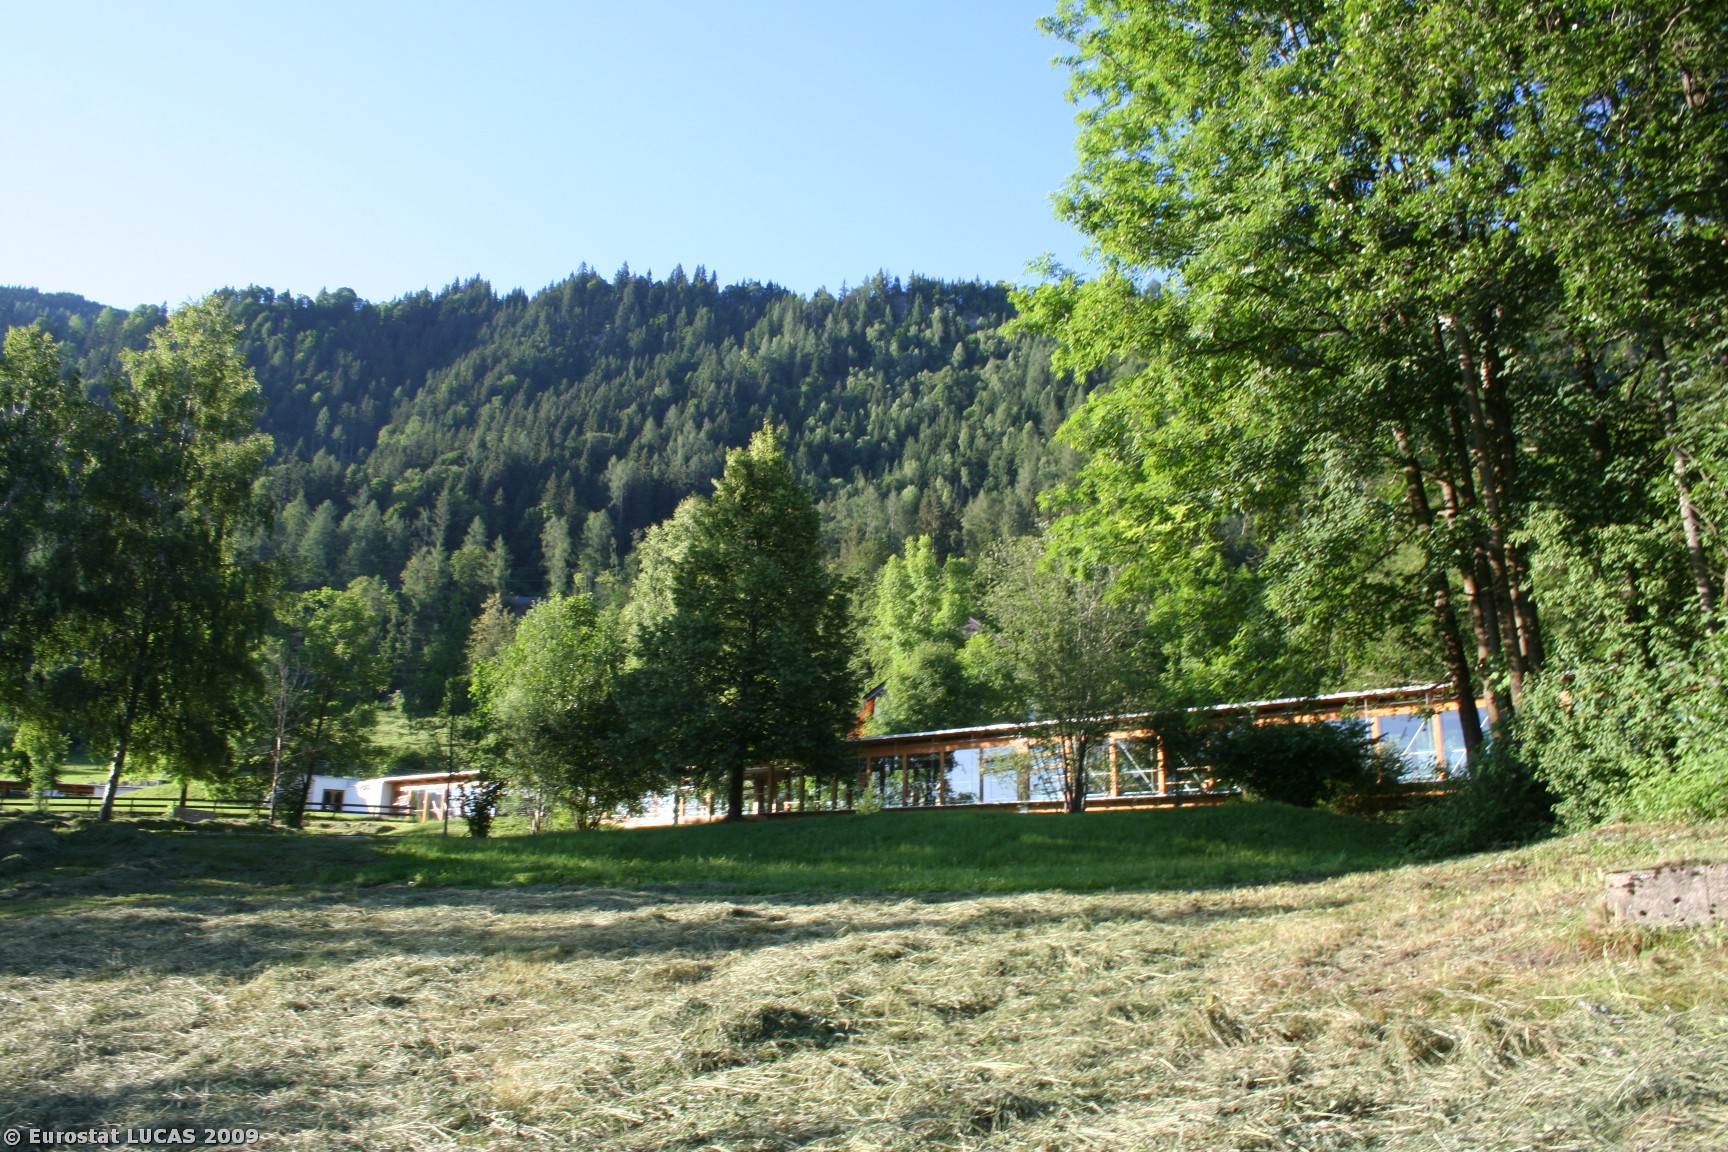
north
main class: Grassland
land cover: Grassland without tree/shrub cover
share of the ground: > 75 %
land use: Agriculture (excluding fallow land and kitchen gardens)
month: June
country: AT
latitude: 47.3317
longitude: 13.1608
